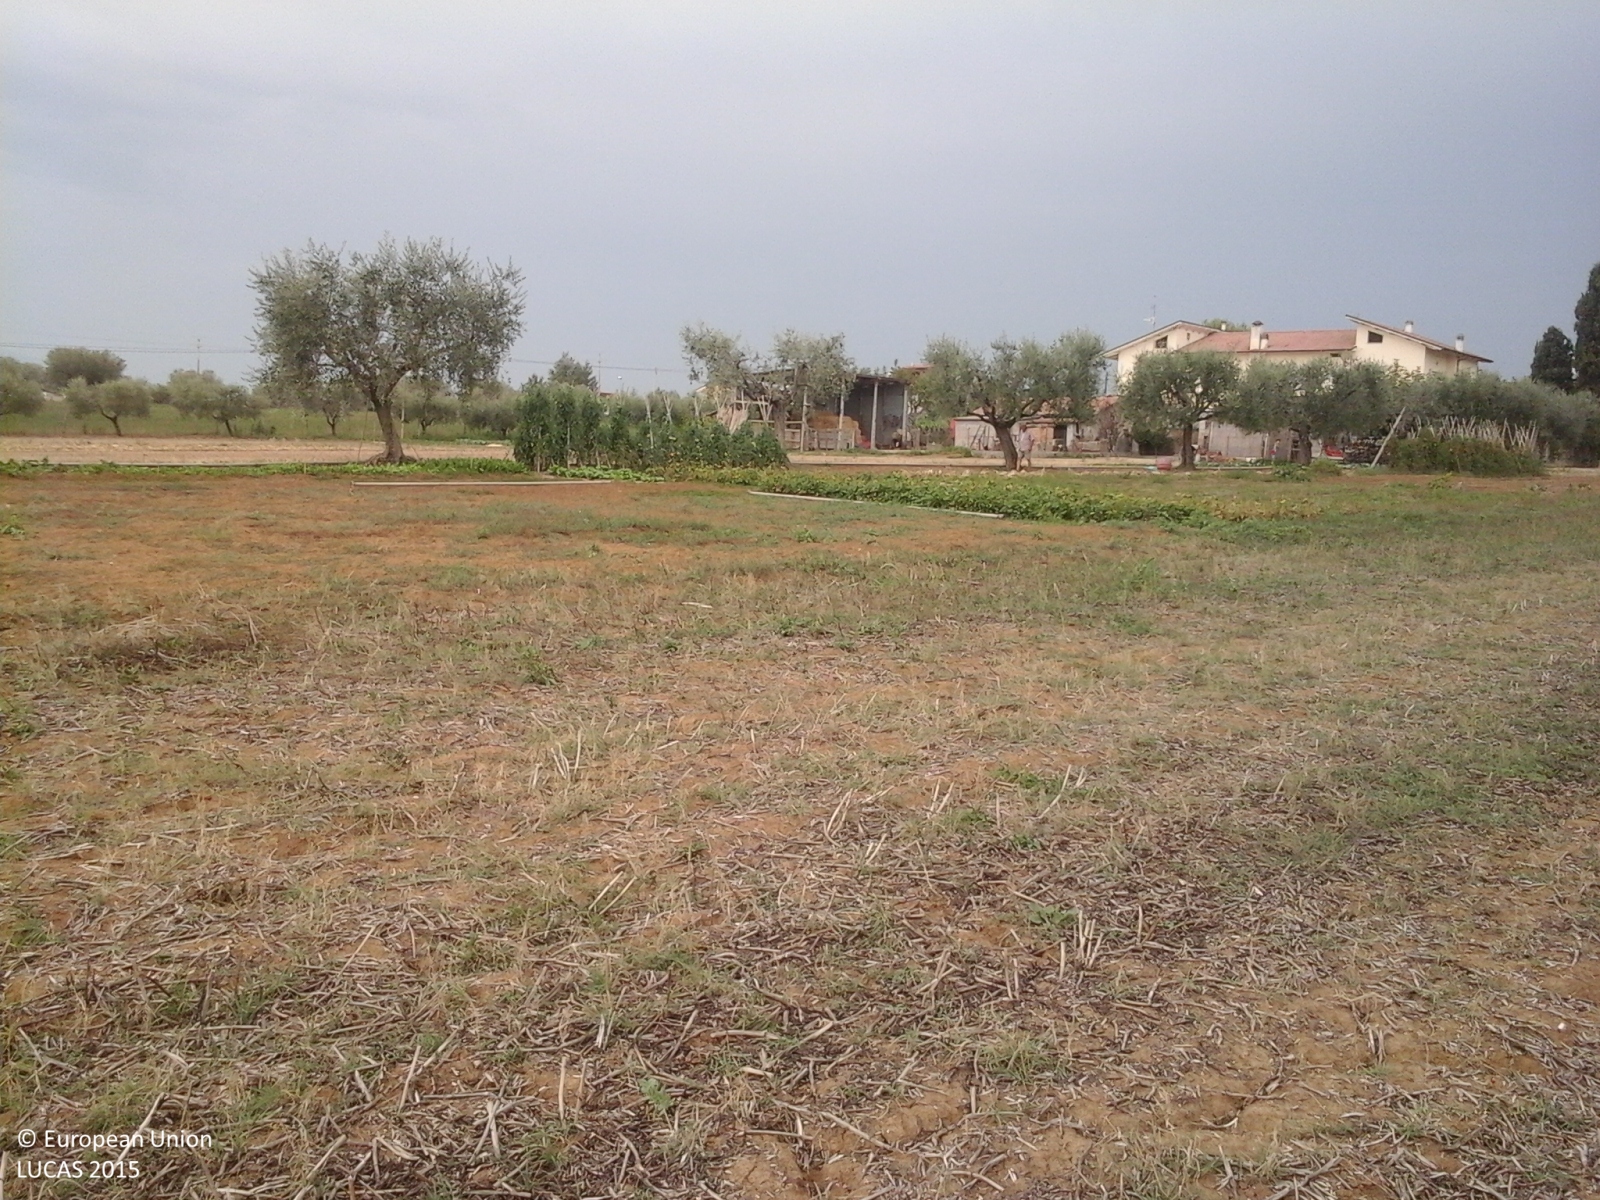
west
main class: Cropland
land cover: Dry pulses
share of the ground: > 75 %
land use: Agriculture (excluding fallow land and kitchen gardens)
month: September
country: IT
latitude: 42.8333
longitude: 13.8674
